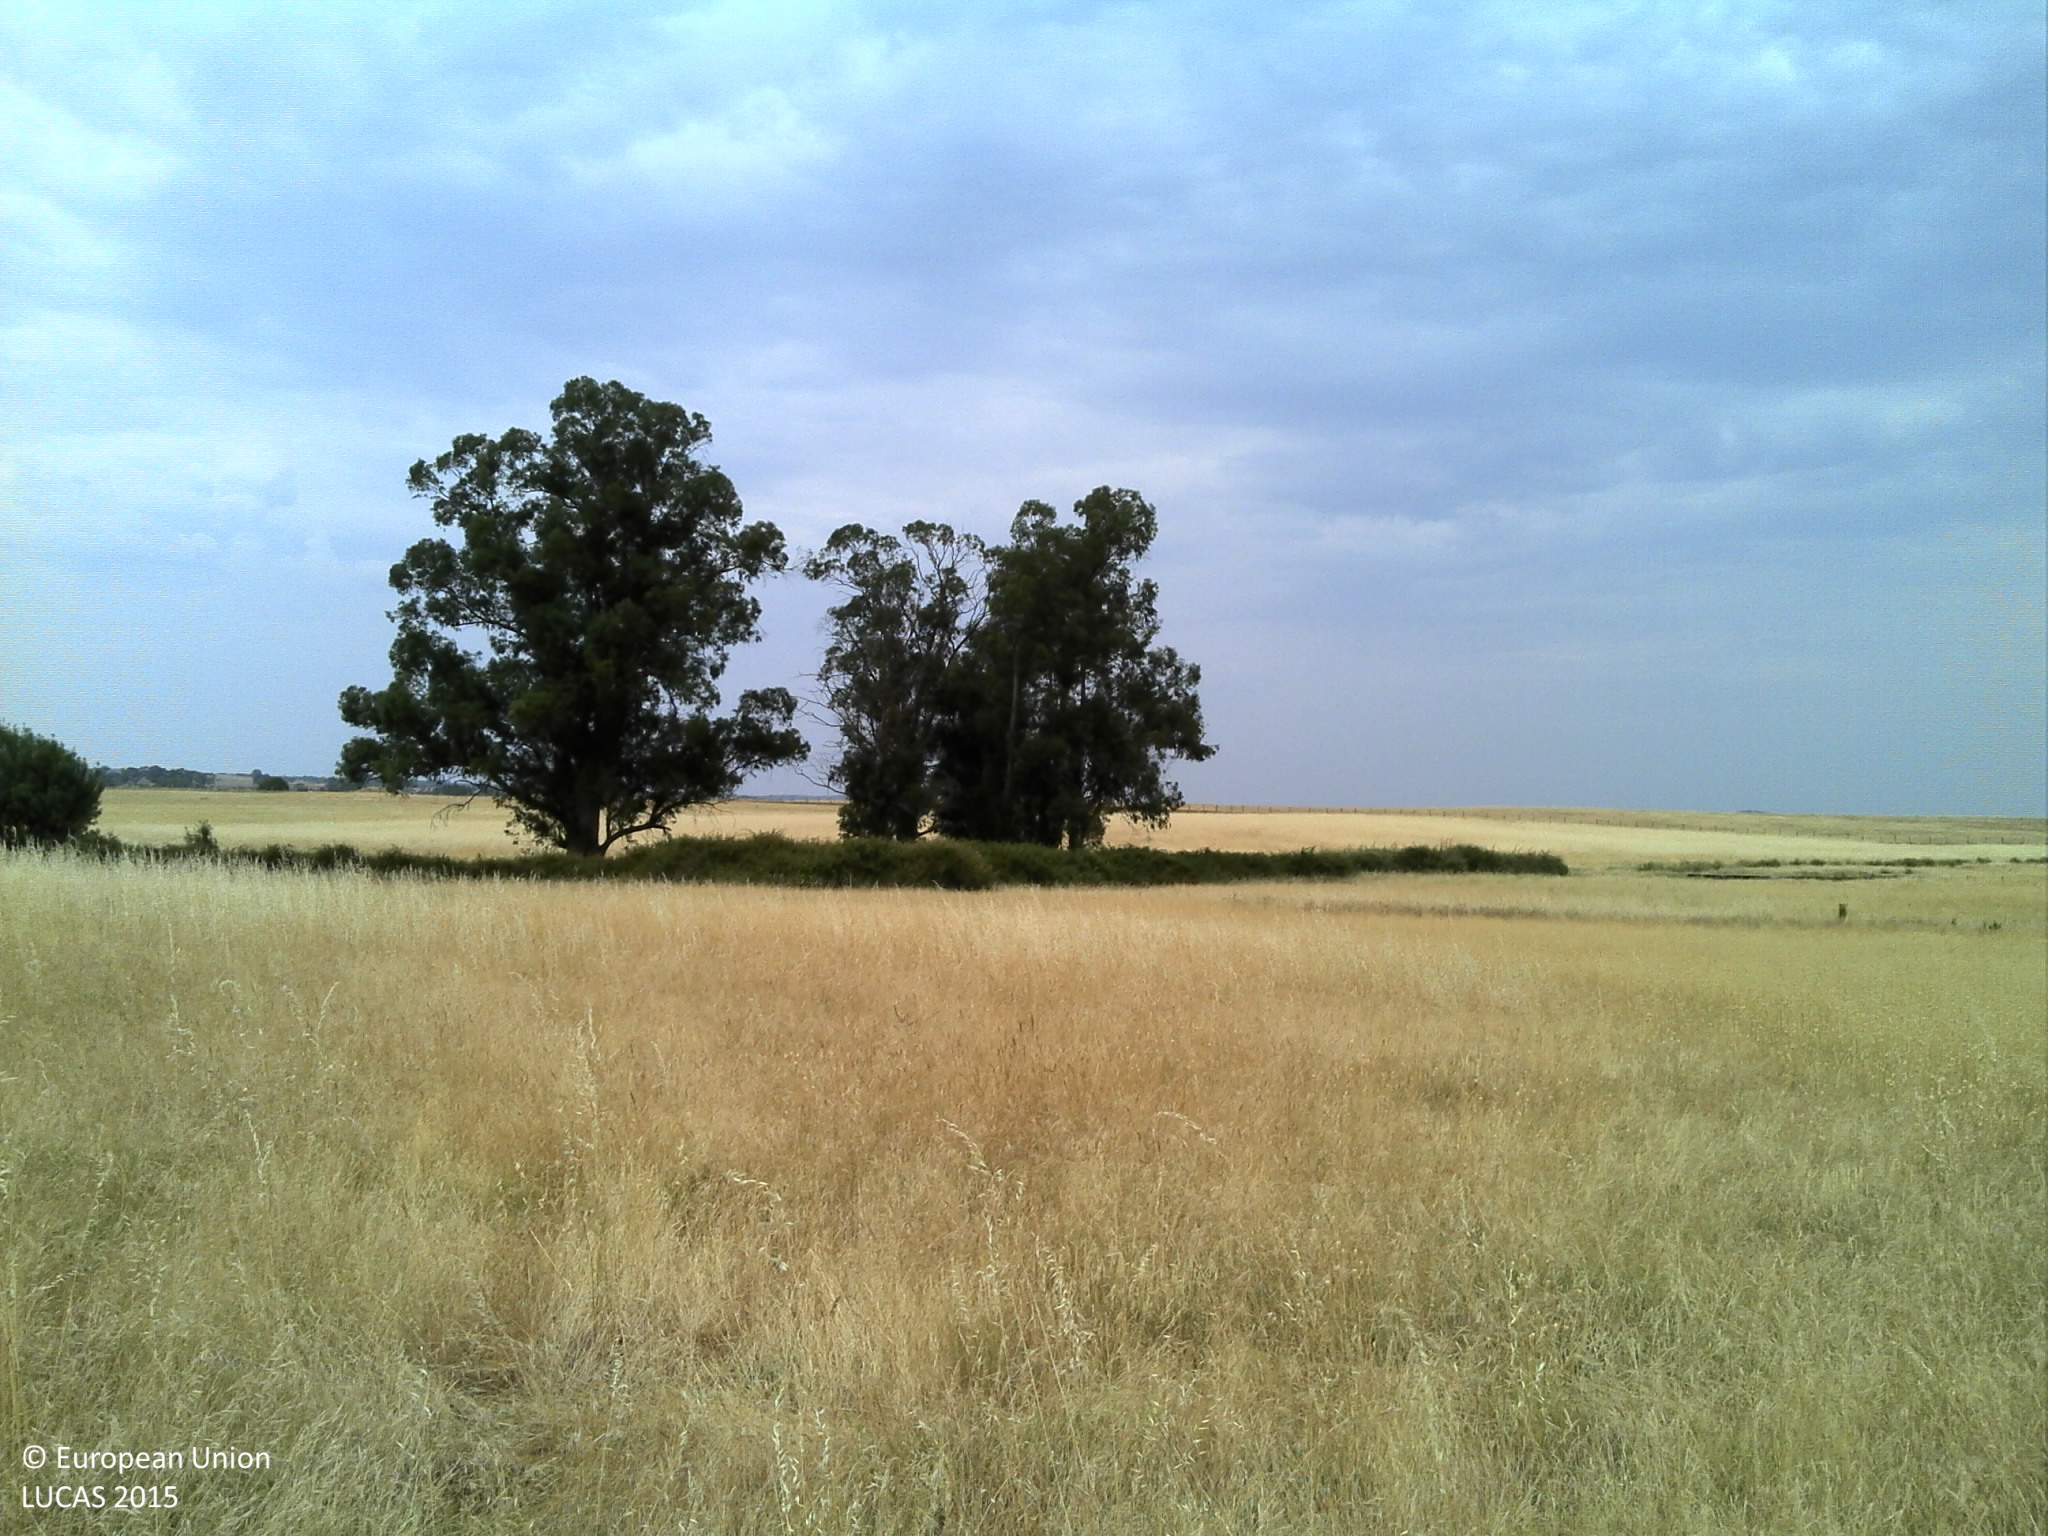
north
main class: Grassland
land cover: Spontaneously vegetated surfaces
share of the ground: 50 - 75 %
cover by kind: herbaceous plants 75 %, unconsolidated bare surface 25 %
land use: Agriculture (excluding fallow land and kitchen gardens)
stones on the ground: < 10 %
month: June
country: PT
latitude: 38.6192
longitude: -7.8293
